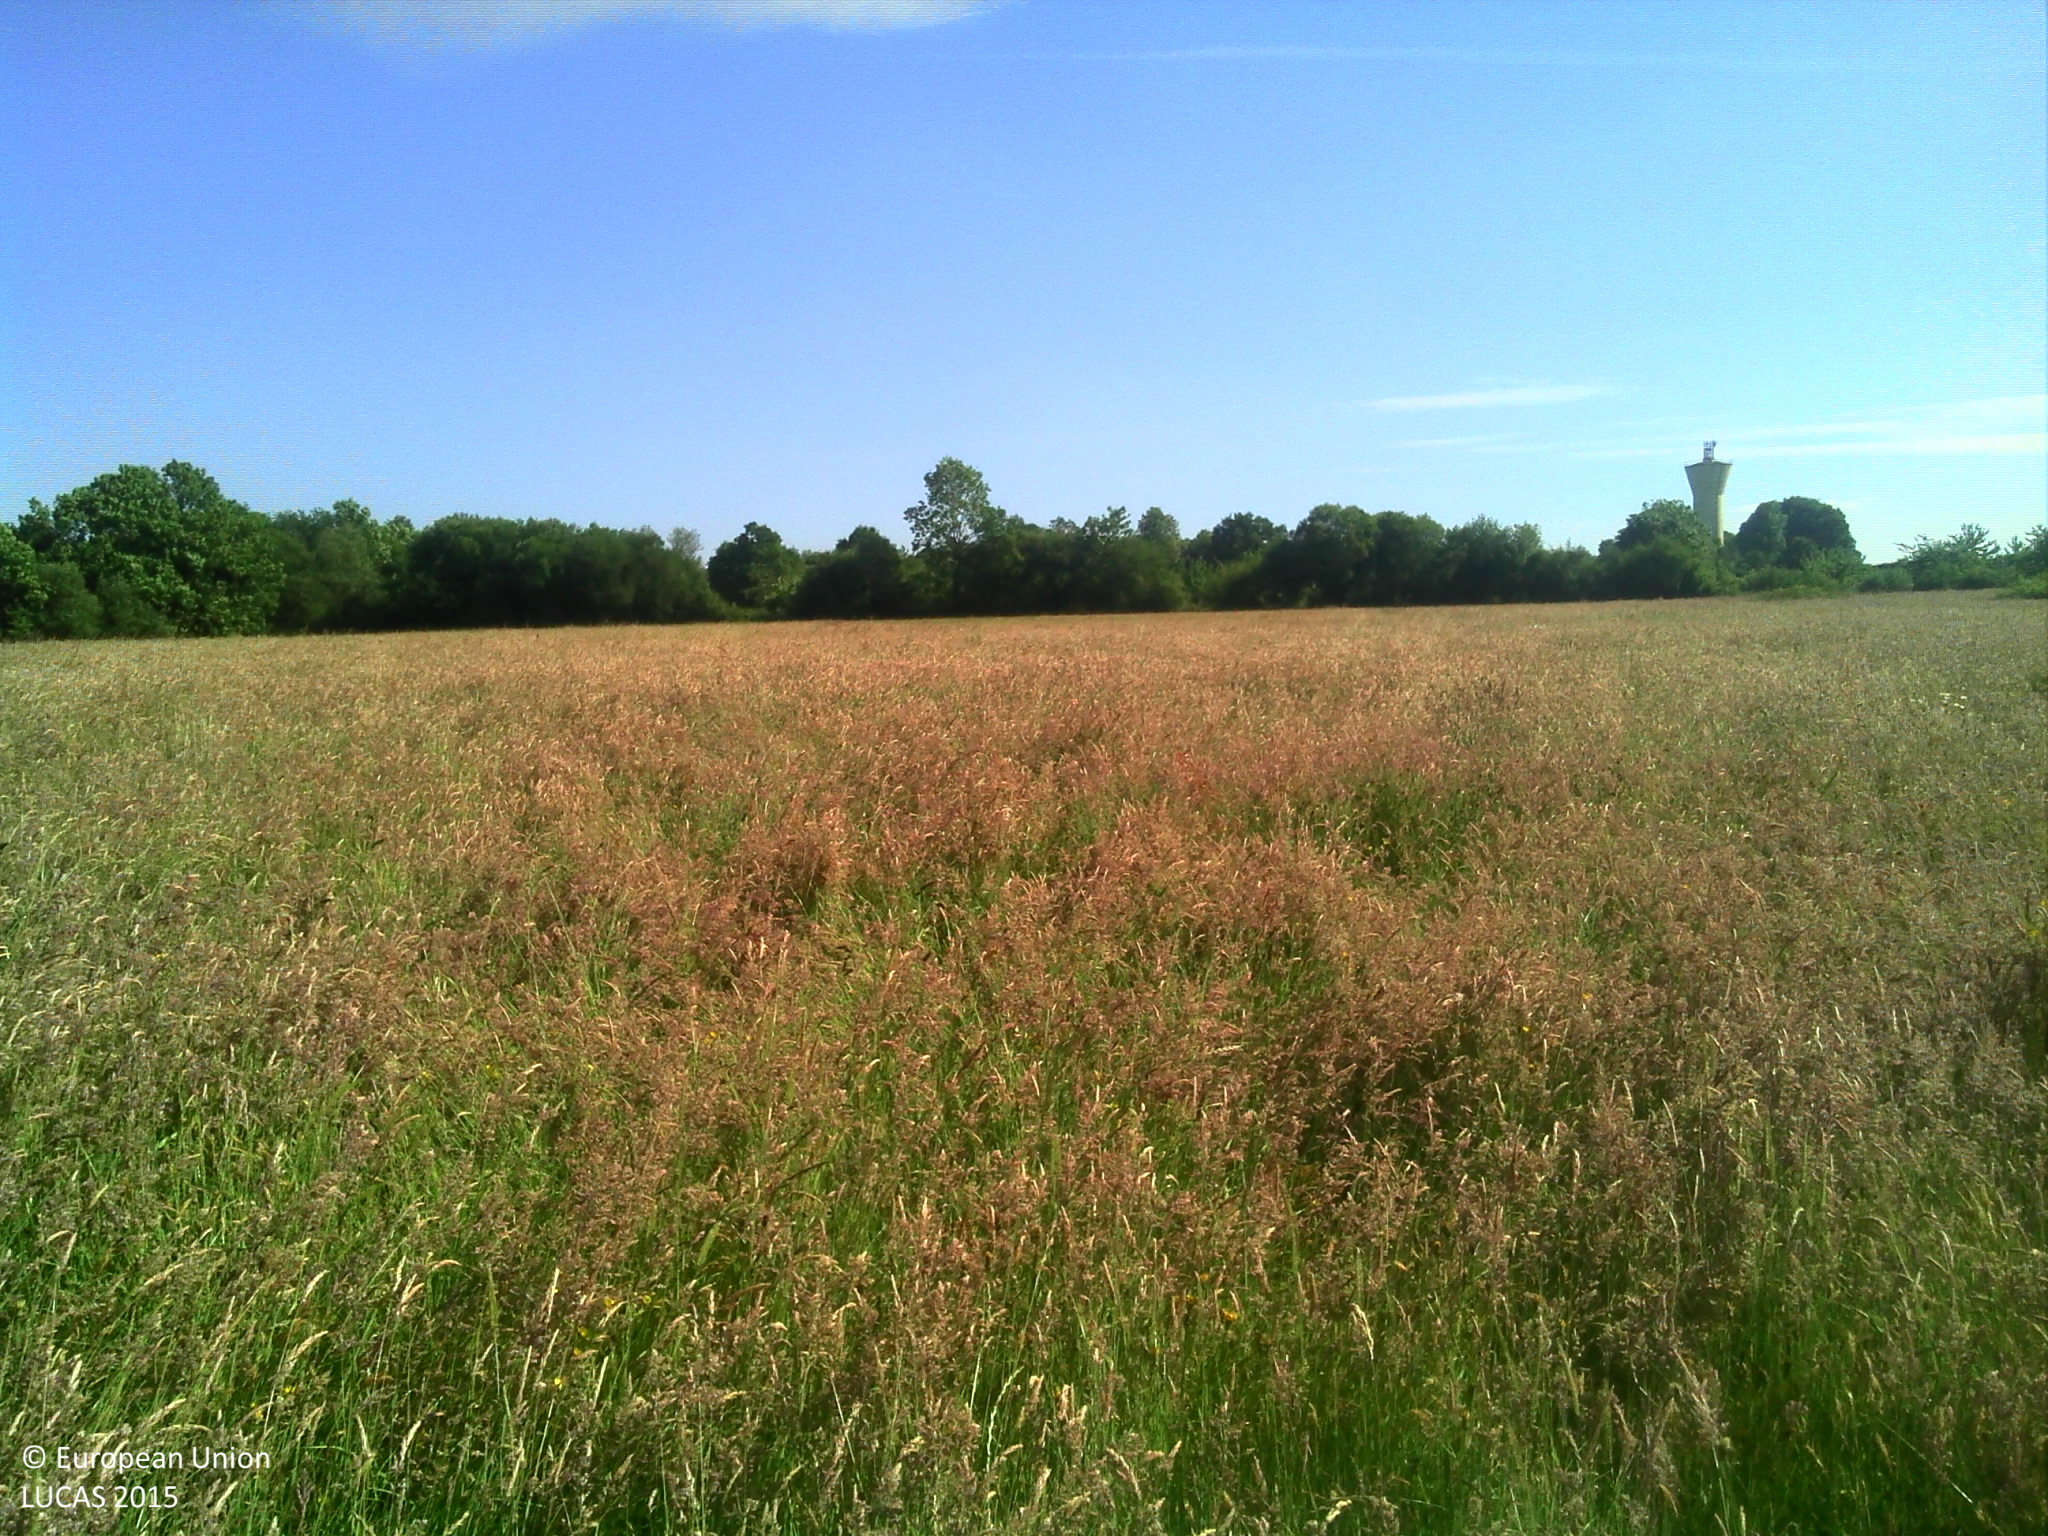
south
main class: Grassland
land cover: Grassland without tree/shrub cover
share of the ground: > 75 %
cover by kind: herbaceous plants 100 %
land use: Agriculture (excluding fallow land and kitchen gardens)
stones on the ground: < 10 %
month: June
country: FR
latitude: 48.5921
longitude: -0.1047
